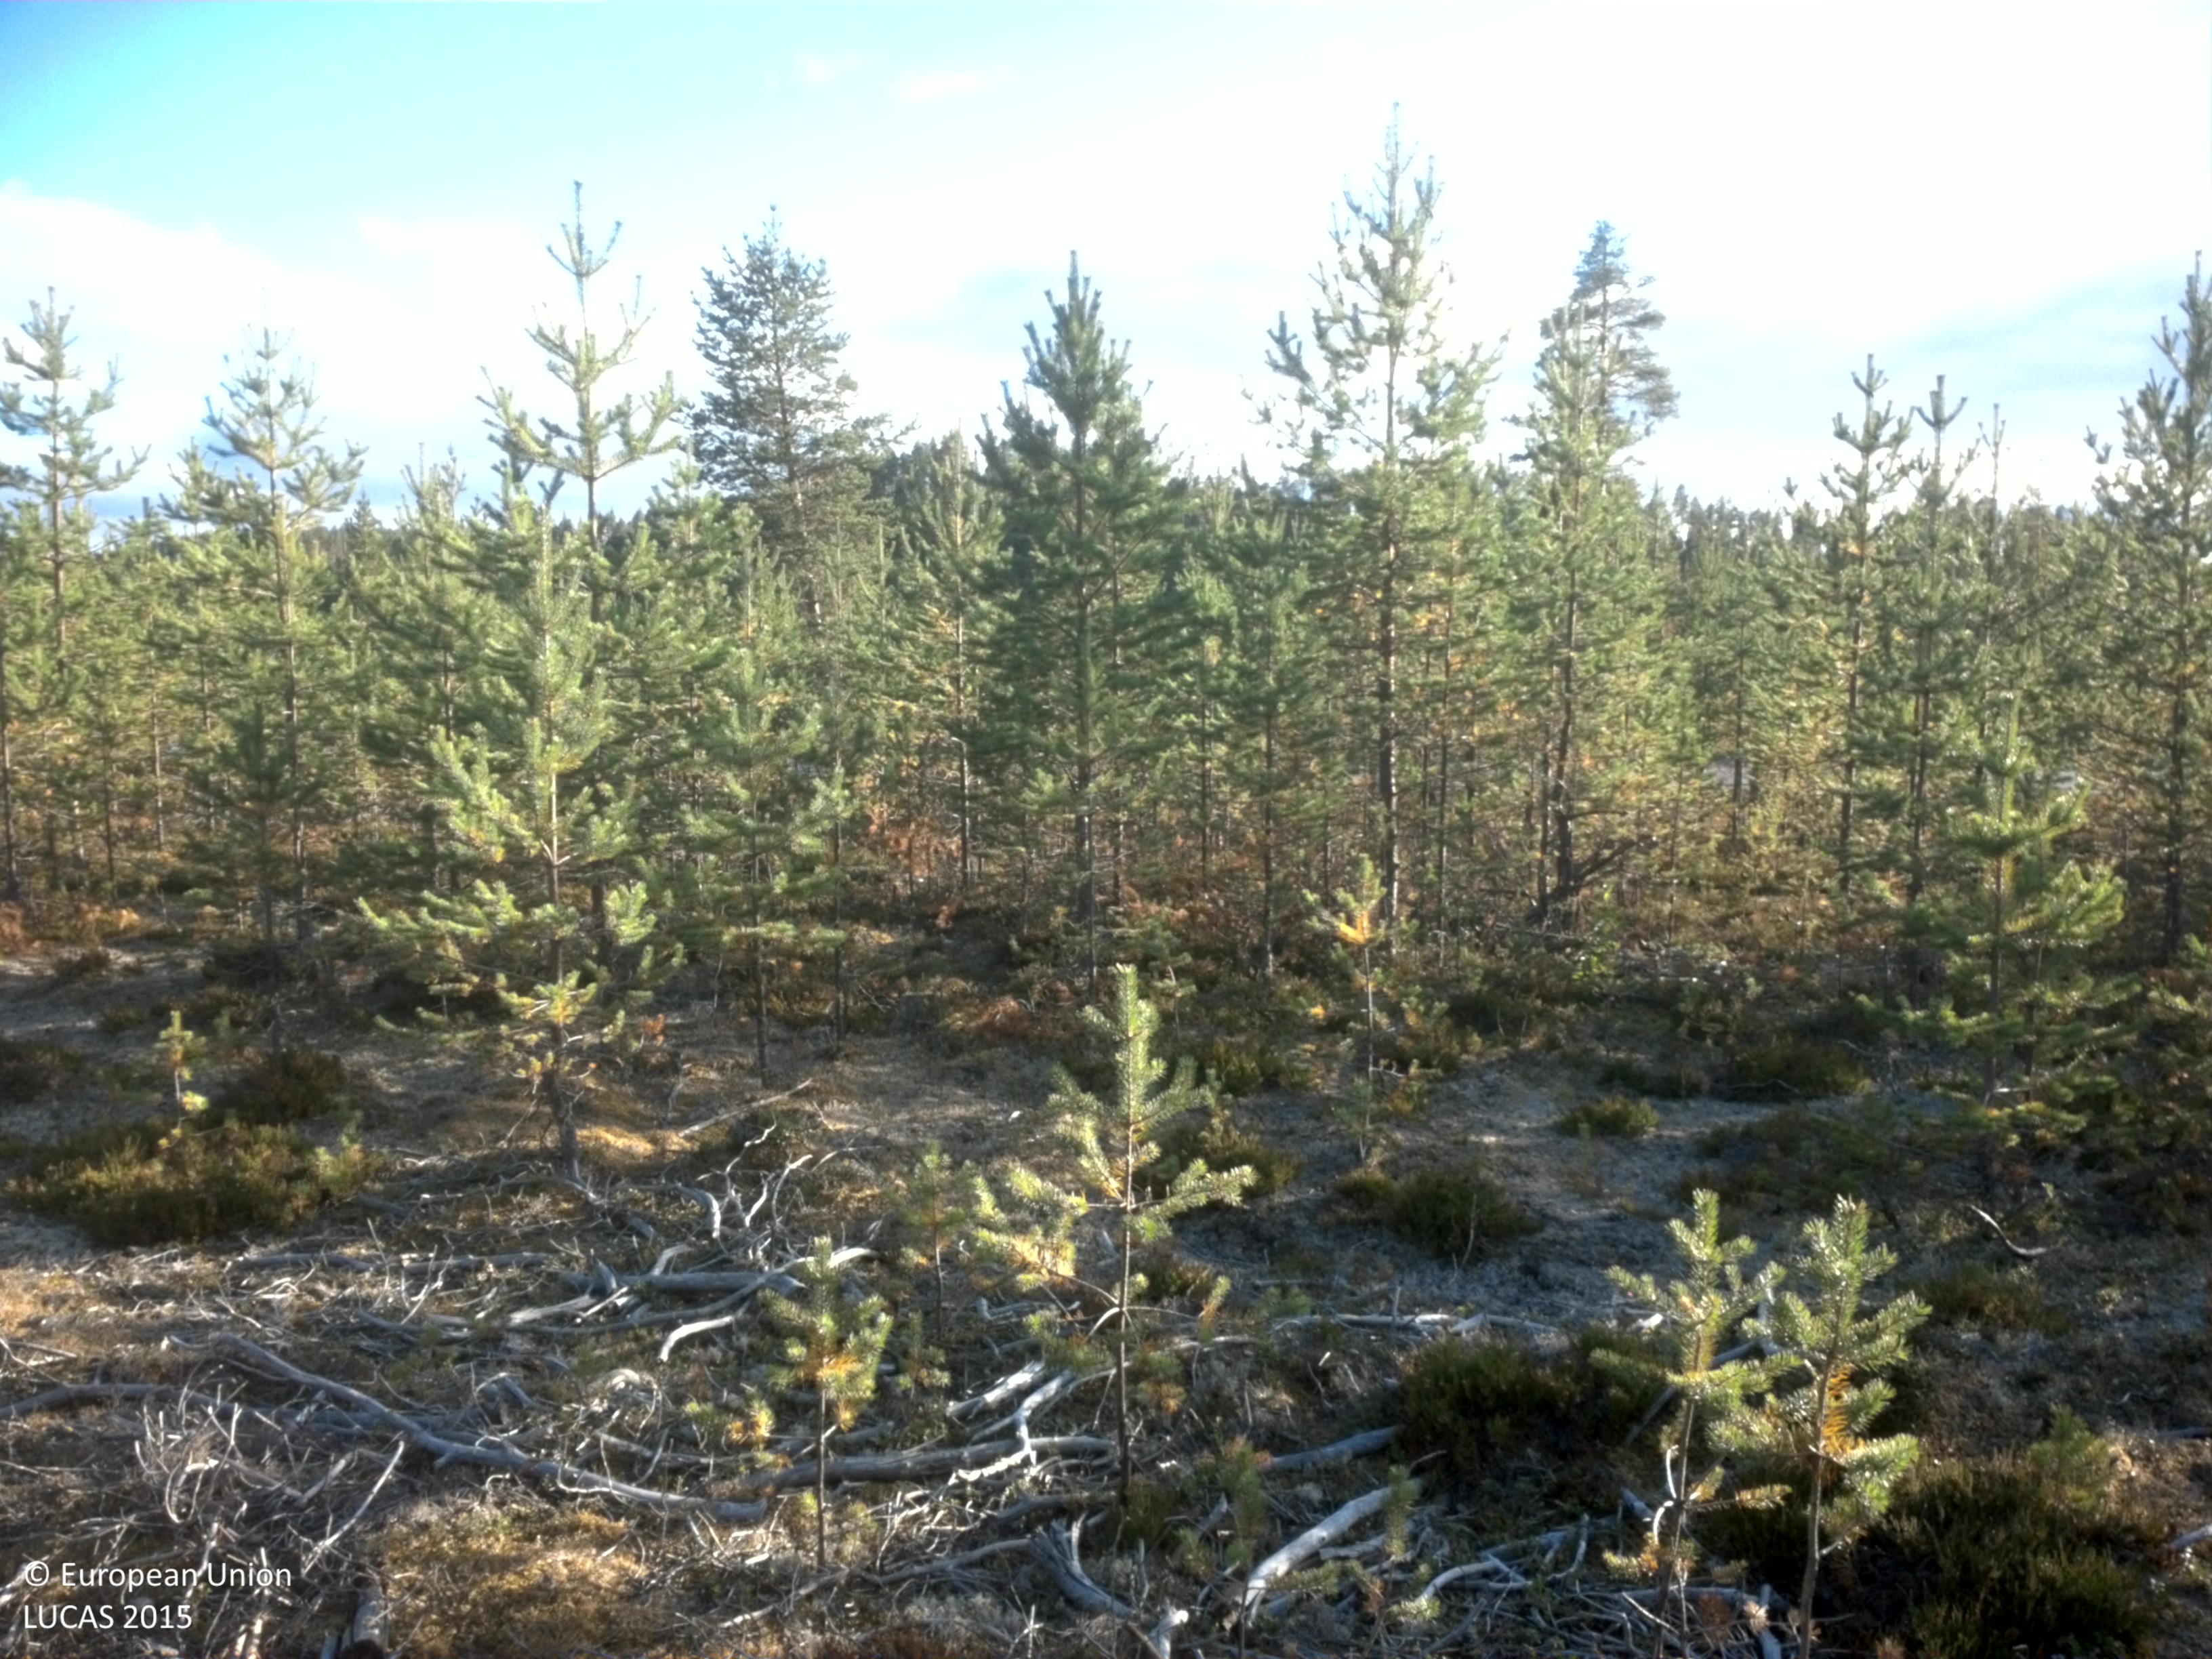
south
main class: Woodland
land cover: Pine dominated coniferous woodland
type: boreal forest
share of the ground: 50 - 75 %
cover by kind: coniferous forest trees 65 %, lichens and mosses 25 %, shrubs 10 %
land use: Forestry
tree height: < 5 m
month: September
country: SE
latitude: 64.4355
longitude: 18.9633
